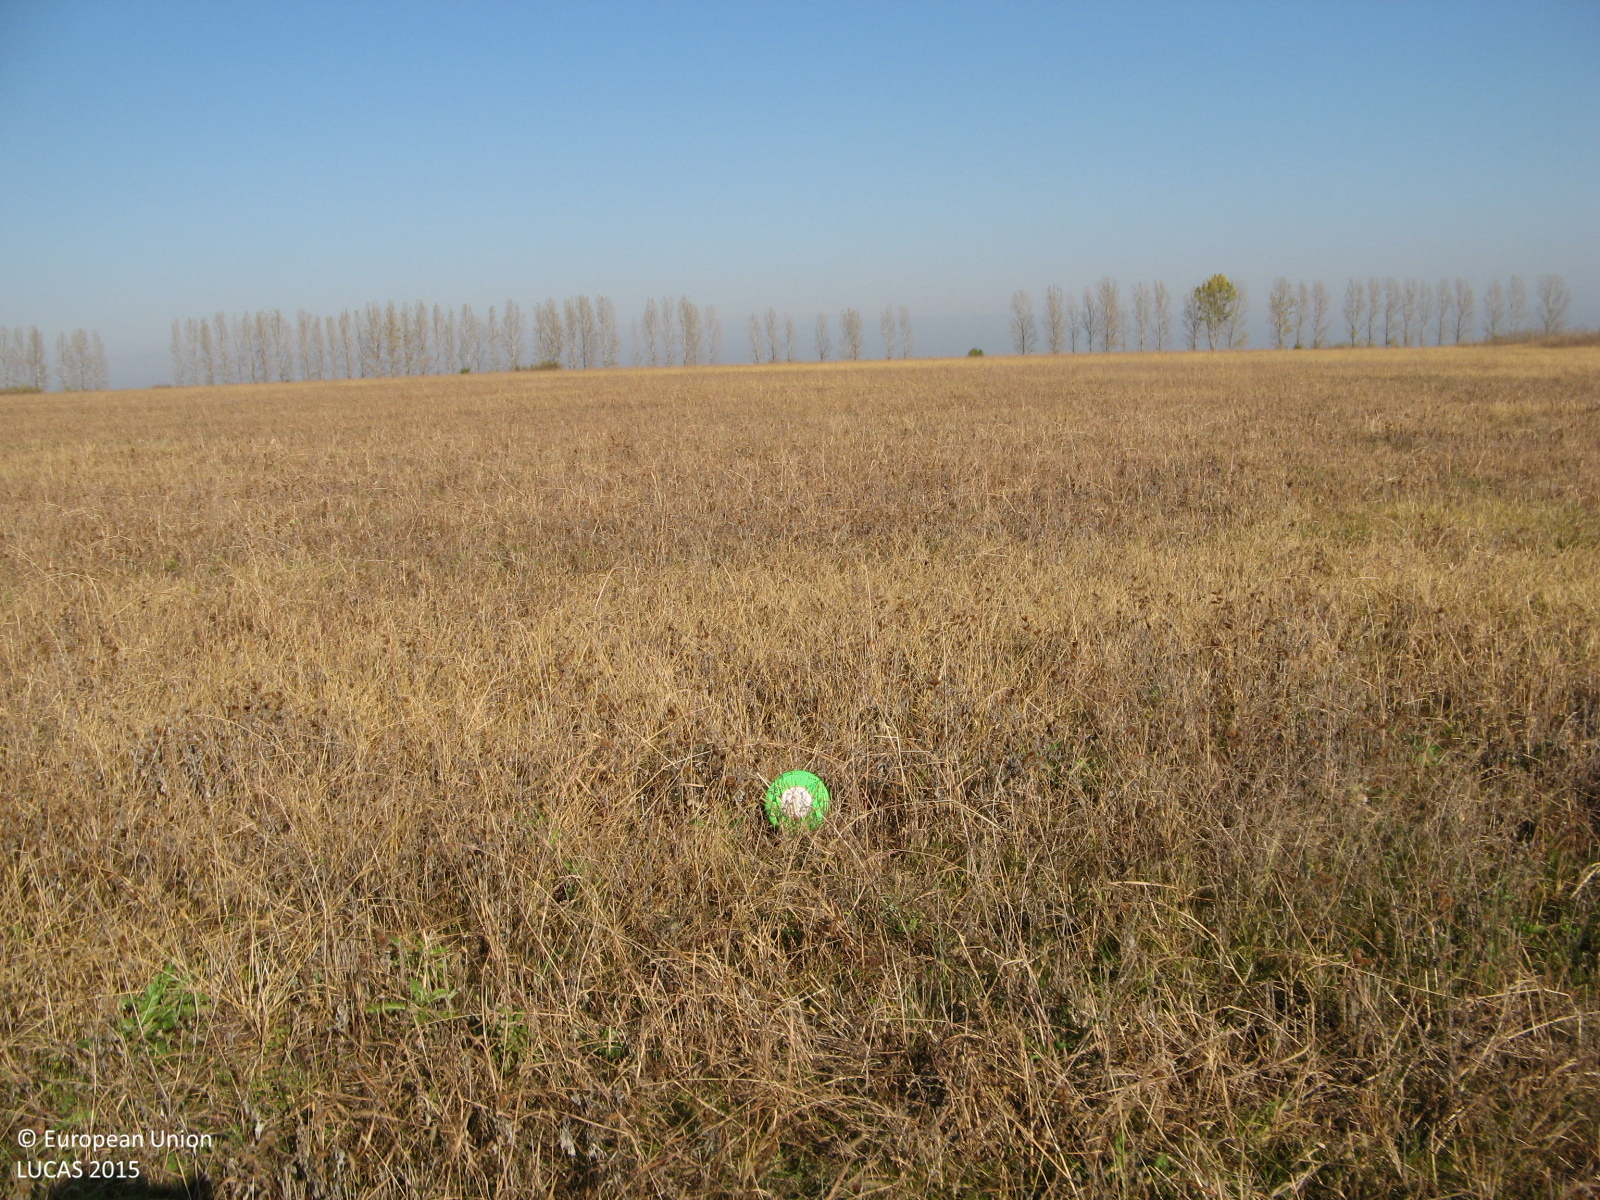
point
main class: Cropland
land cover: Common wheat
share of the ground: < 10 %
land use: Agriculture (excluding fallow land and kitchen gardens)
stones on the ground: < 10 %
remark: Harvested field
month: November
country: BG
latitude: 42.0008
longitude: 25.0375
